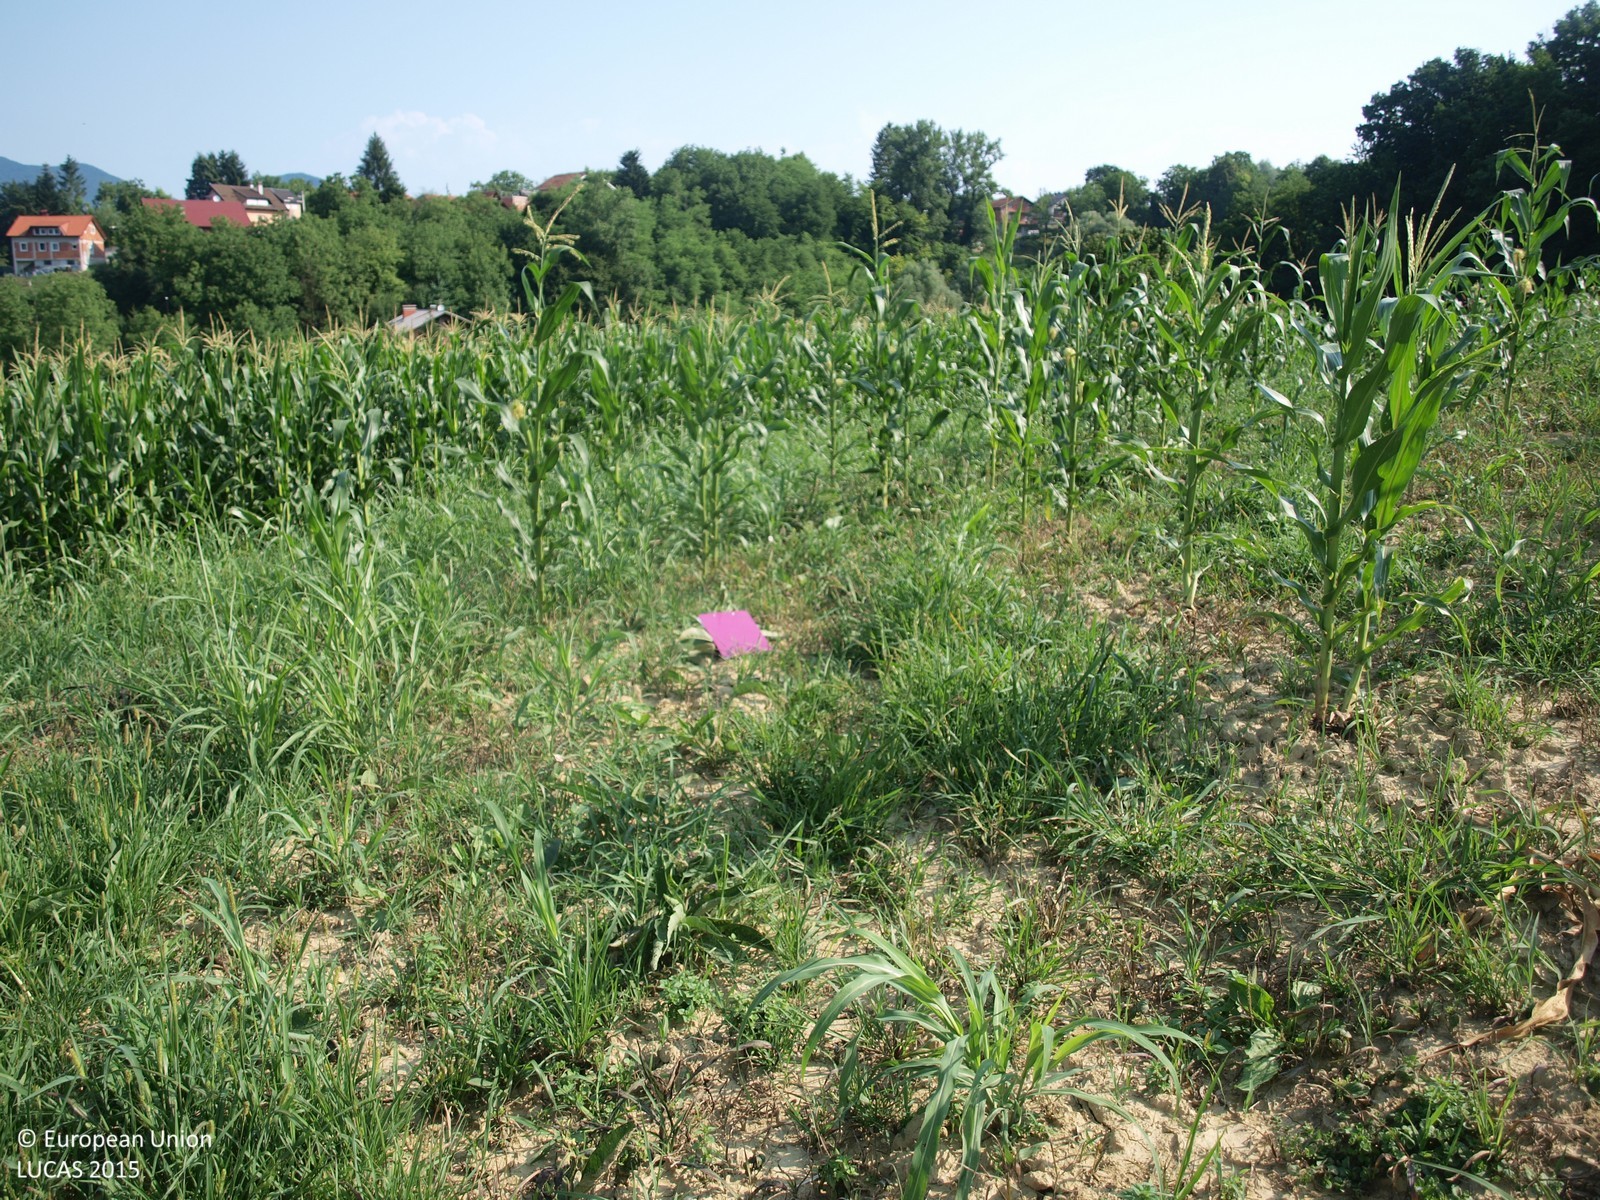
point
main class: Cropland
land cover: Maize
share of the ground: 10 - 25 %
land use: Agriculture (excluding fallow land and kitchen gardens)
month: July
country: HR
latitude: 46.1320
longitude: 15.9396
